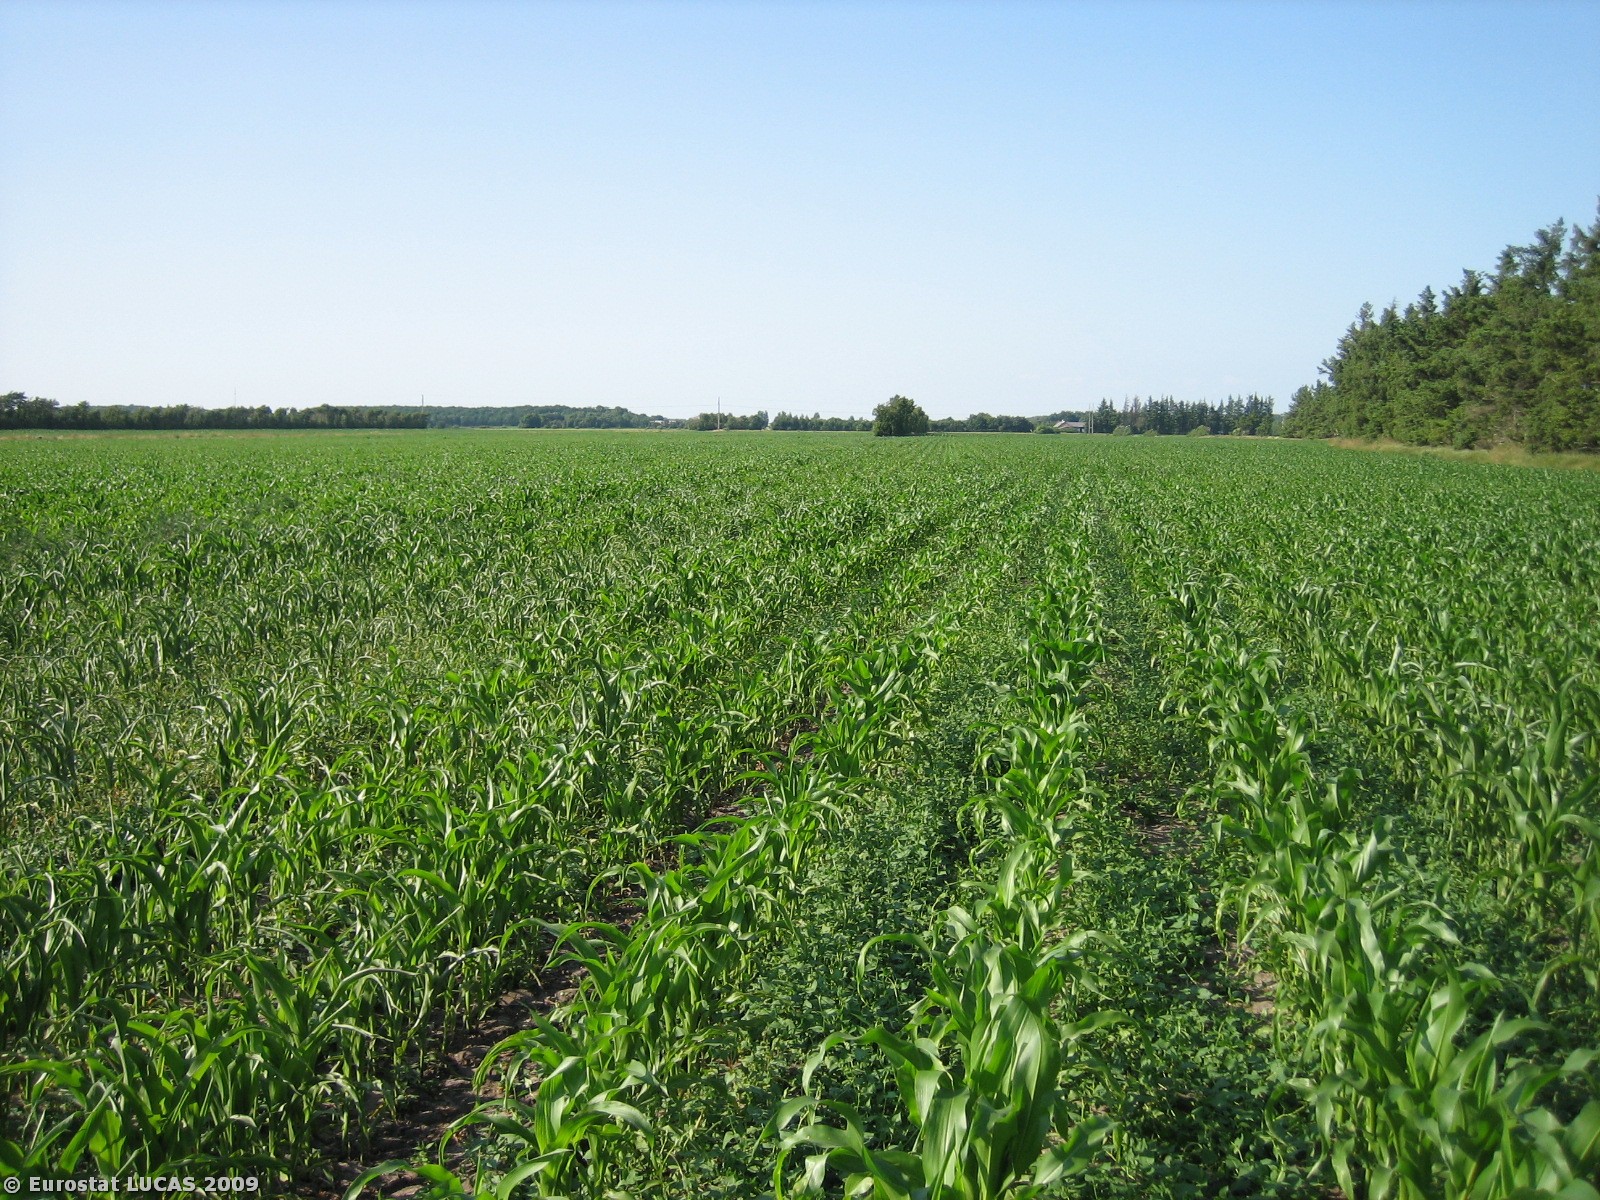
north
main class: Cropland
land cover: Maize
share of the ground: 25 - 50 %
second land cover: Dry pulses
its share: 50 - 75 %
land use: Agriculture (excluding fallow land and kitchen gardens)
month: July
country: DK
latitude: 55.3380
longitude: 8.8816
